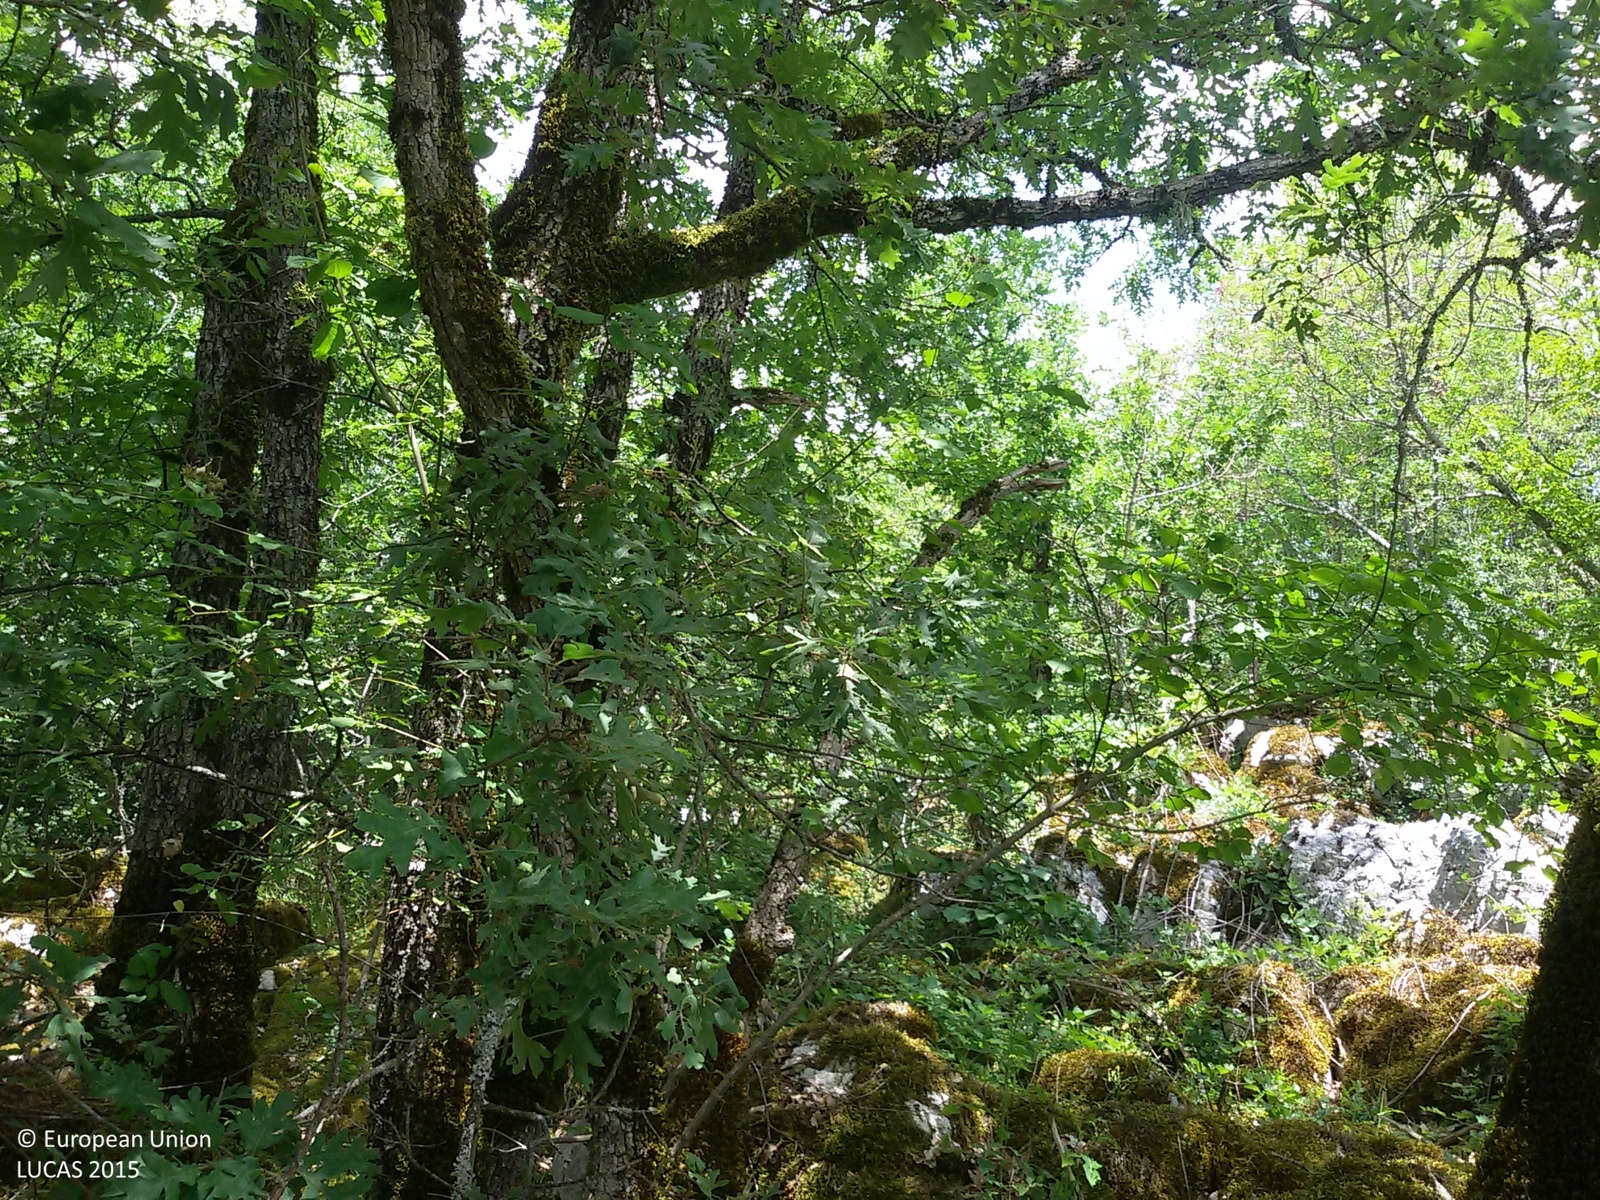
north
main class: Woodland
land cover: Broadleaved woodland
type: acidophilous oak and oak-birch forest
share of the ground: 50 - 75 %
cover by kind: broadleaved forest trees 60 %, lichens and mosses 15 %, shrubs 10 %, consolidated bare surface 10 %, unconsolidated bare surface 5 %
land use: Semi-natural and natural areas not in use
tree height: > 5 m
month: June
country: HR
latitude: 44.5471
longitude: 15.5192
